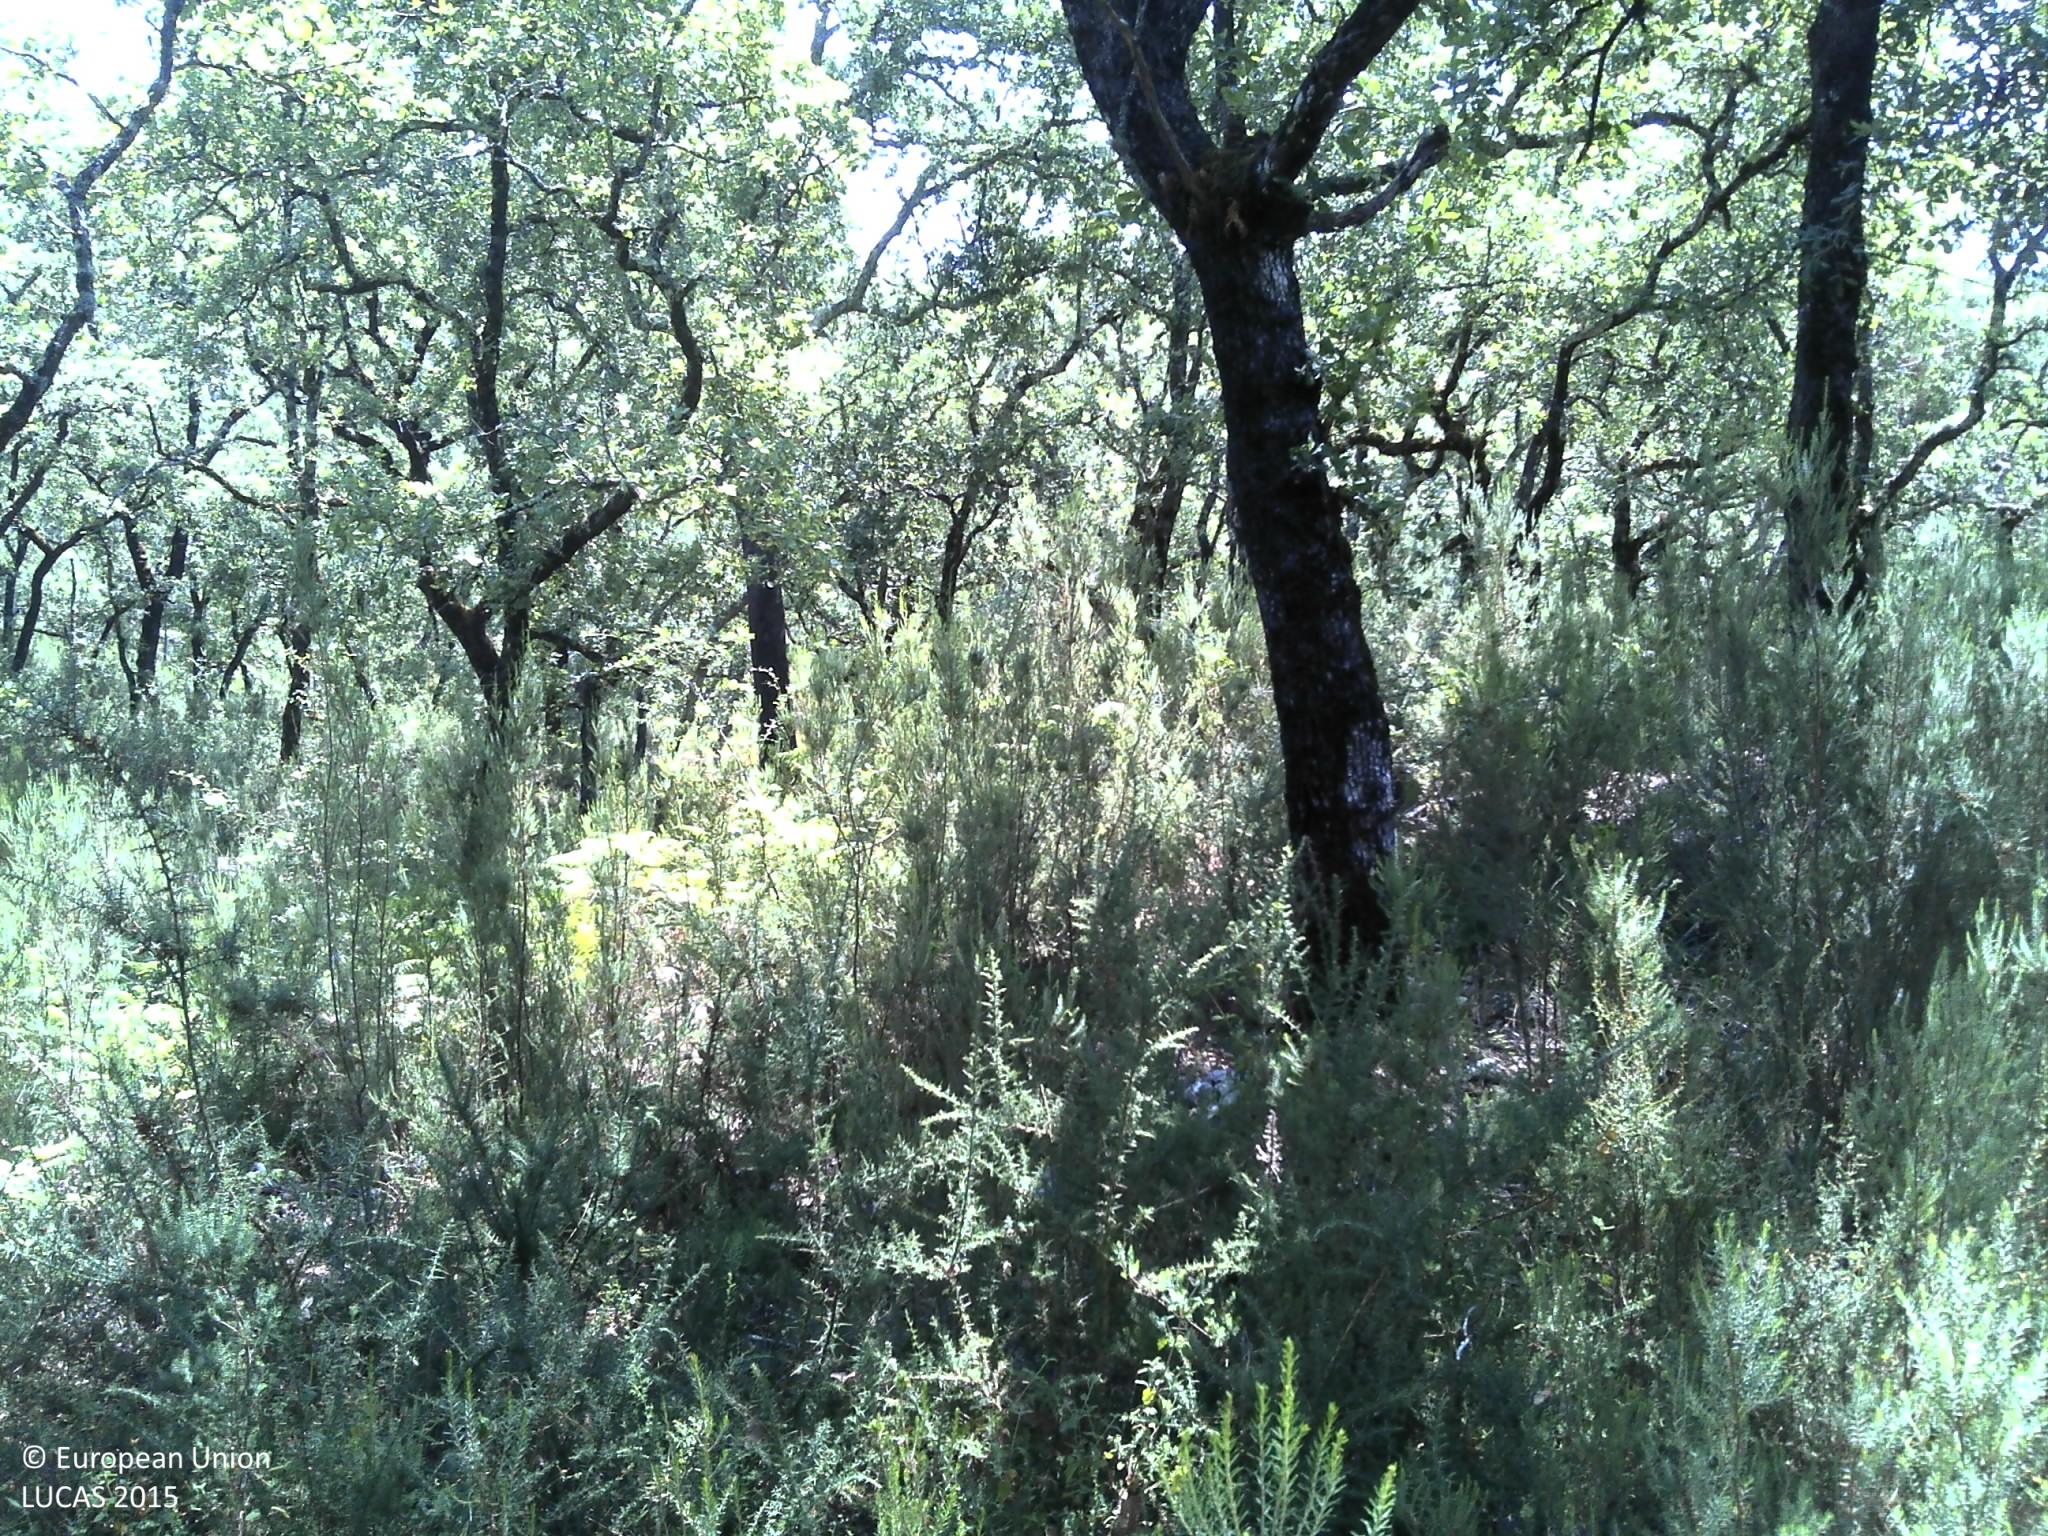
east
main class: Woodland
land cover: Broadleaved woodland
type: thermophilous deciduous forest
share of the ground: 25 - 50 %
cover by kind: broadleaved forest trees 50 %, shrubs 30 %, unconsolidated bare surface 20 %
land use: Forestry
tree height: > 5 m
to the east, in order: Broadleaved woodland
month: July
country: PT
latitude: 39.9928
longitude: -8.4808
